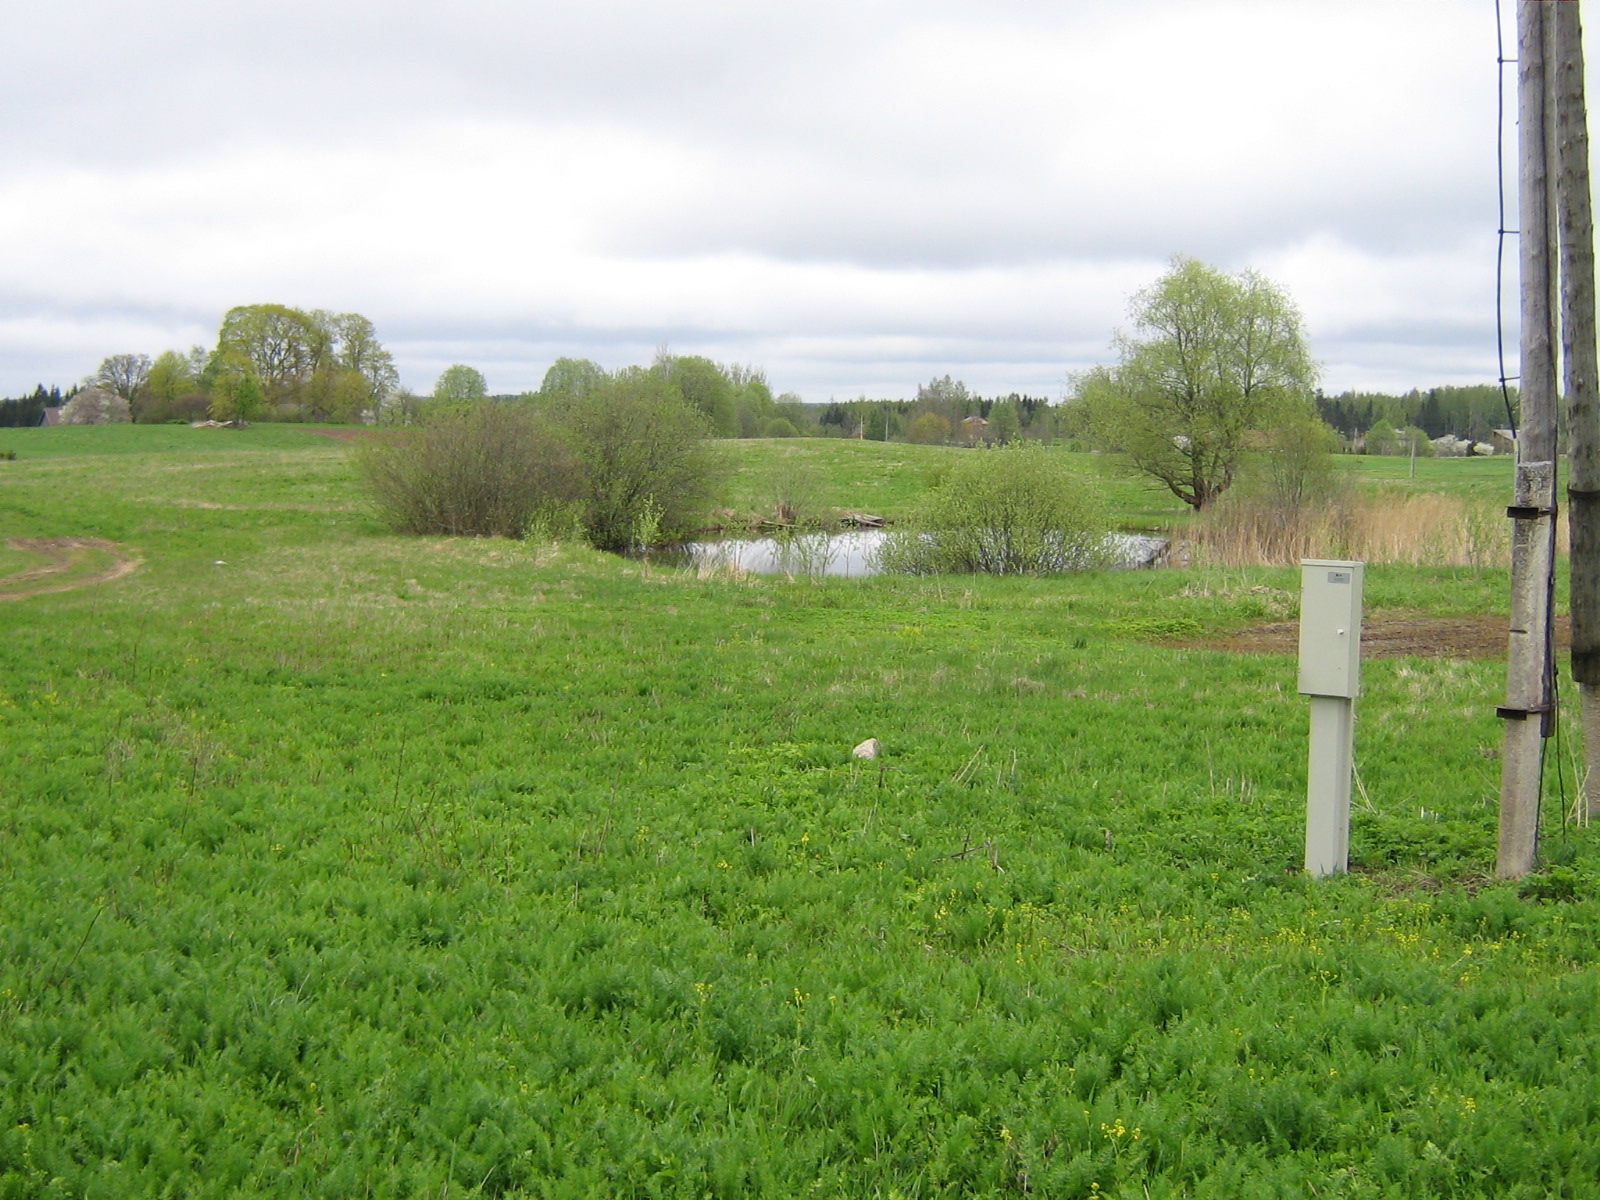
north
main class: Grassland
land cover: Grassland without tree/shrub cover
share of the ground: > 75 %
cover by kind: herbaceous plants 100 %
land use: Agriculture (excluding fallow land and kitchen gardens)
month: May
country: LV
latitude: 57.1692
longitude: 25.3103
